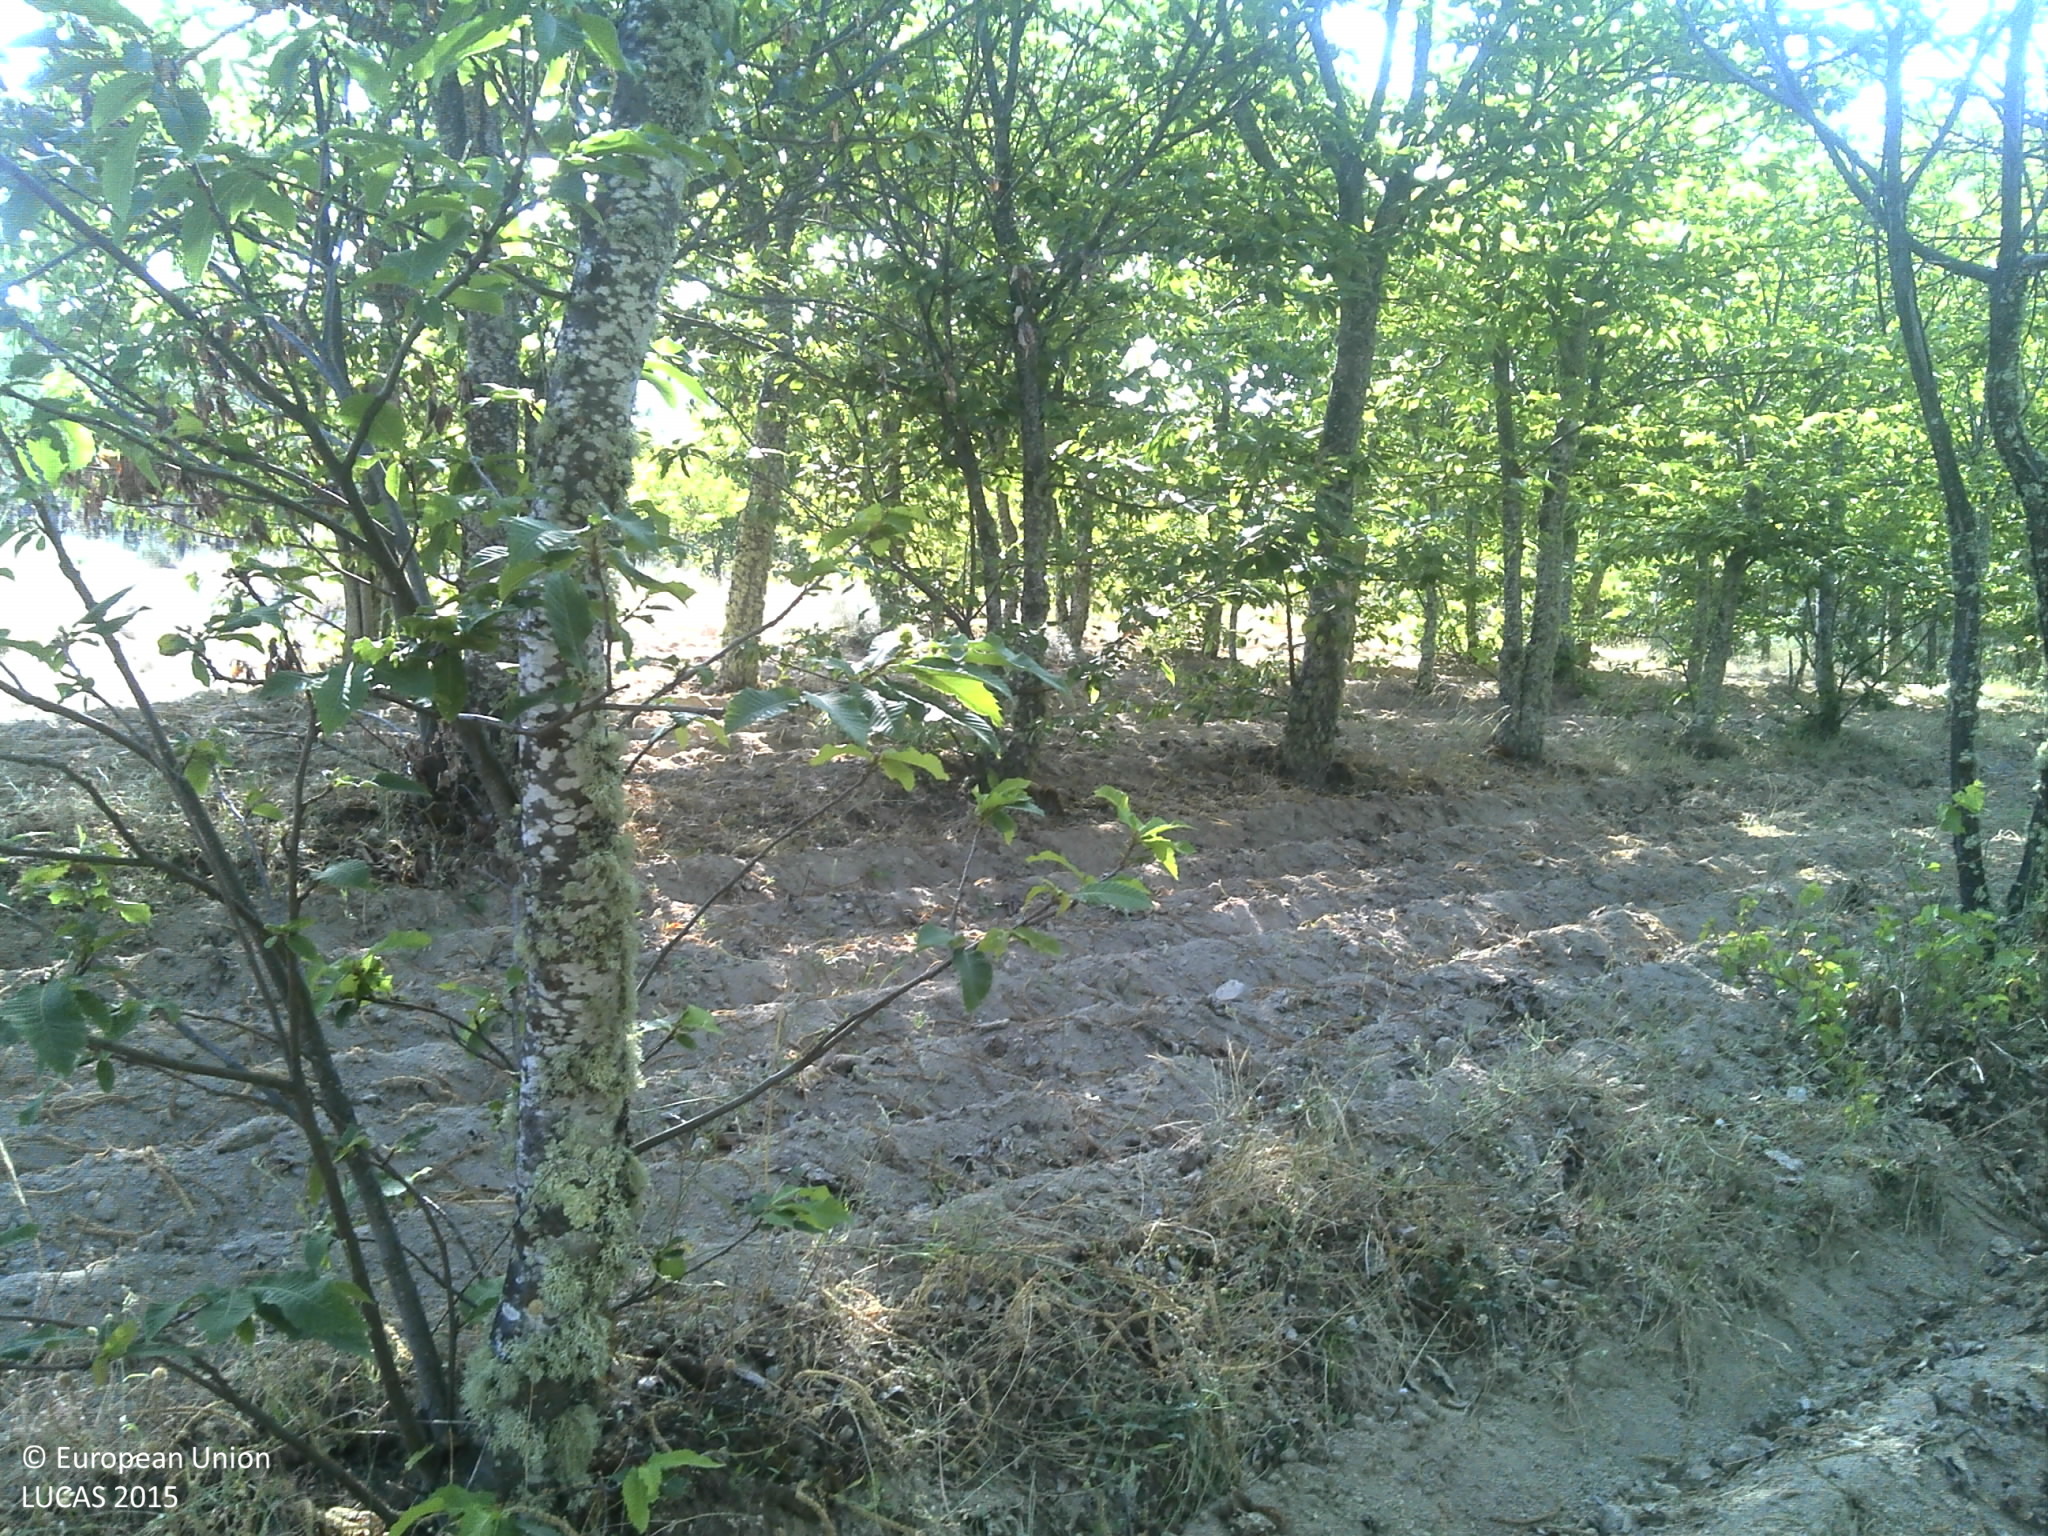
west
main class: Cropland
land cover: Nuts trees
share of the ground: 50 - 75 %
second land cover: Other bare soil
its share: > 75 %
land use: Agriculture (excluding fallow land and kitchen gardens)
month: July
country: PT
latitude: 40.8527
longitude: -7.3244
